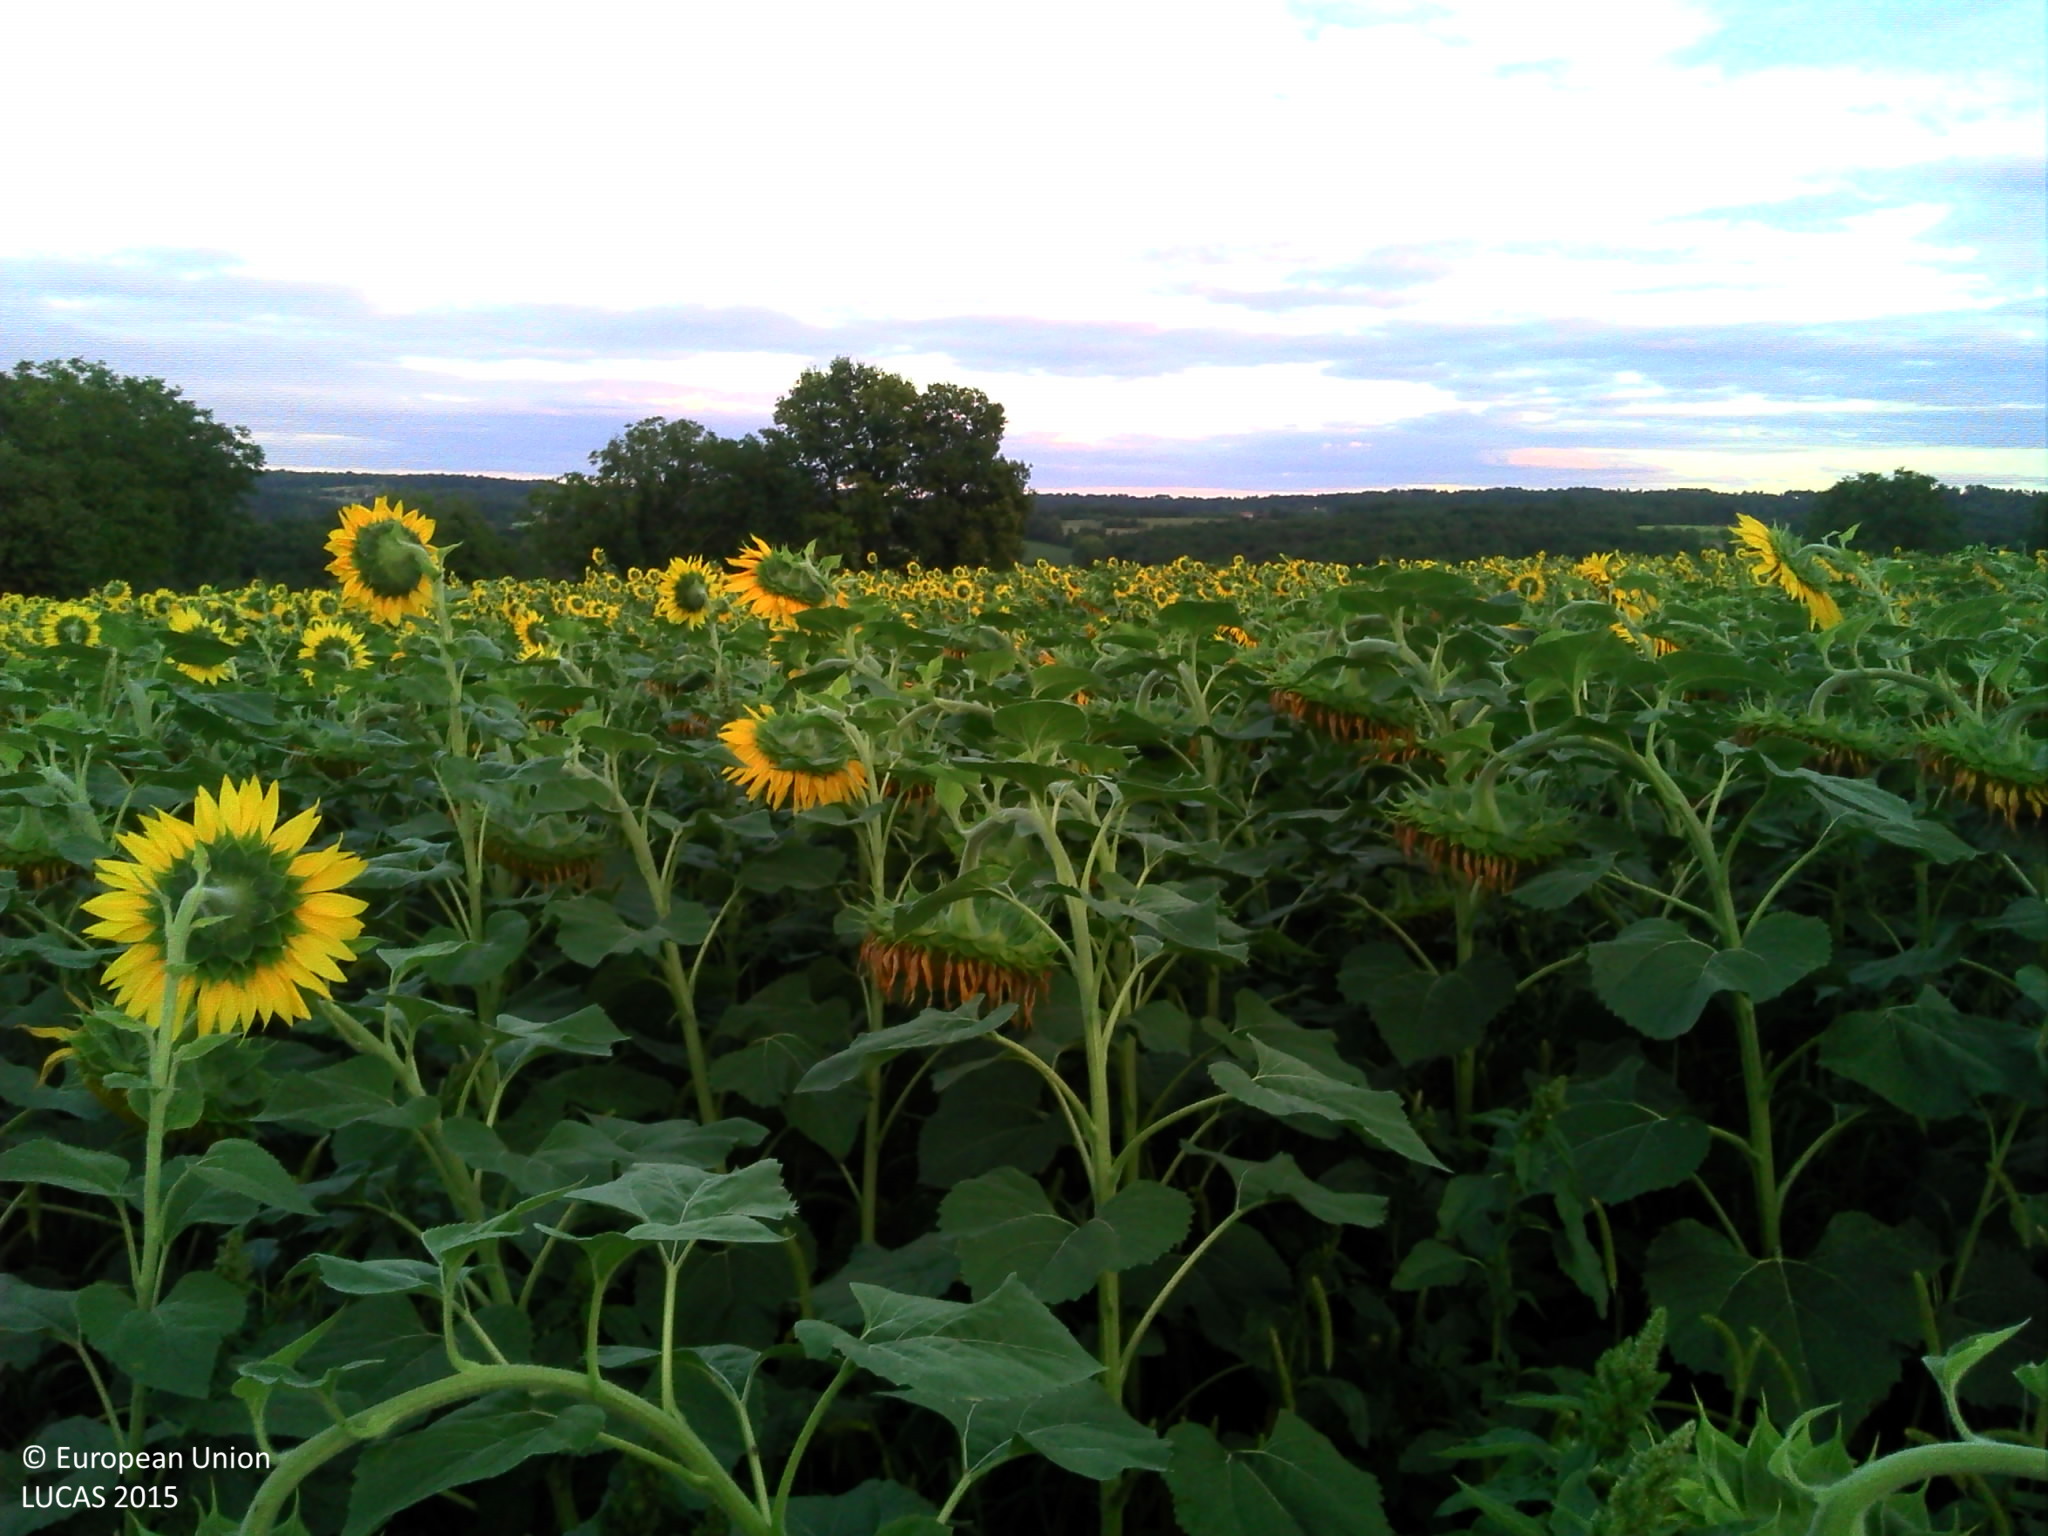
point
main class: Cropland
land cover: Sunflower
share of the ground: > 75 %
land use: Agriculture (excluding fallow land and kitchen gardens)
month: August
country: FR
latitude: 45.2336
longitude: 0.4474
